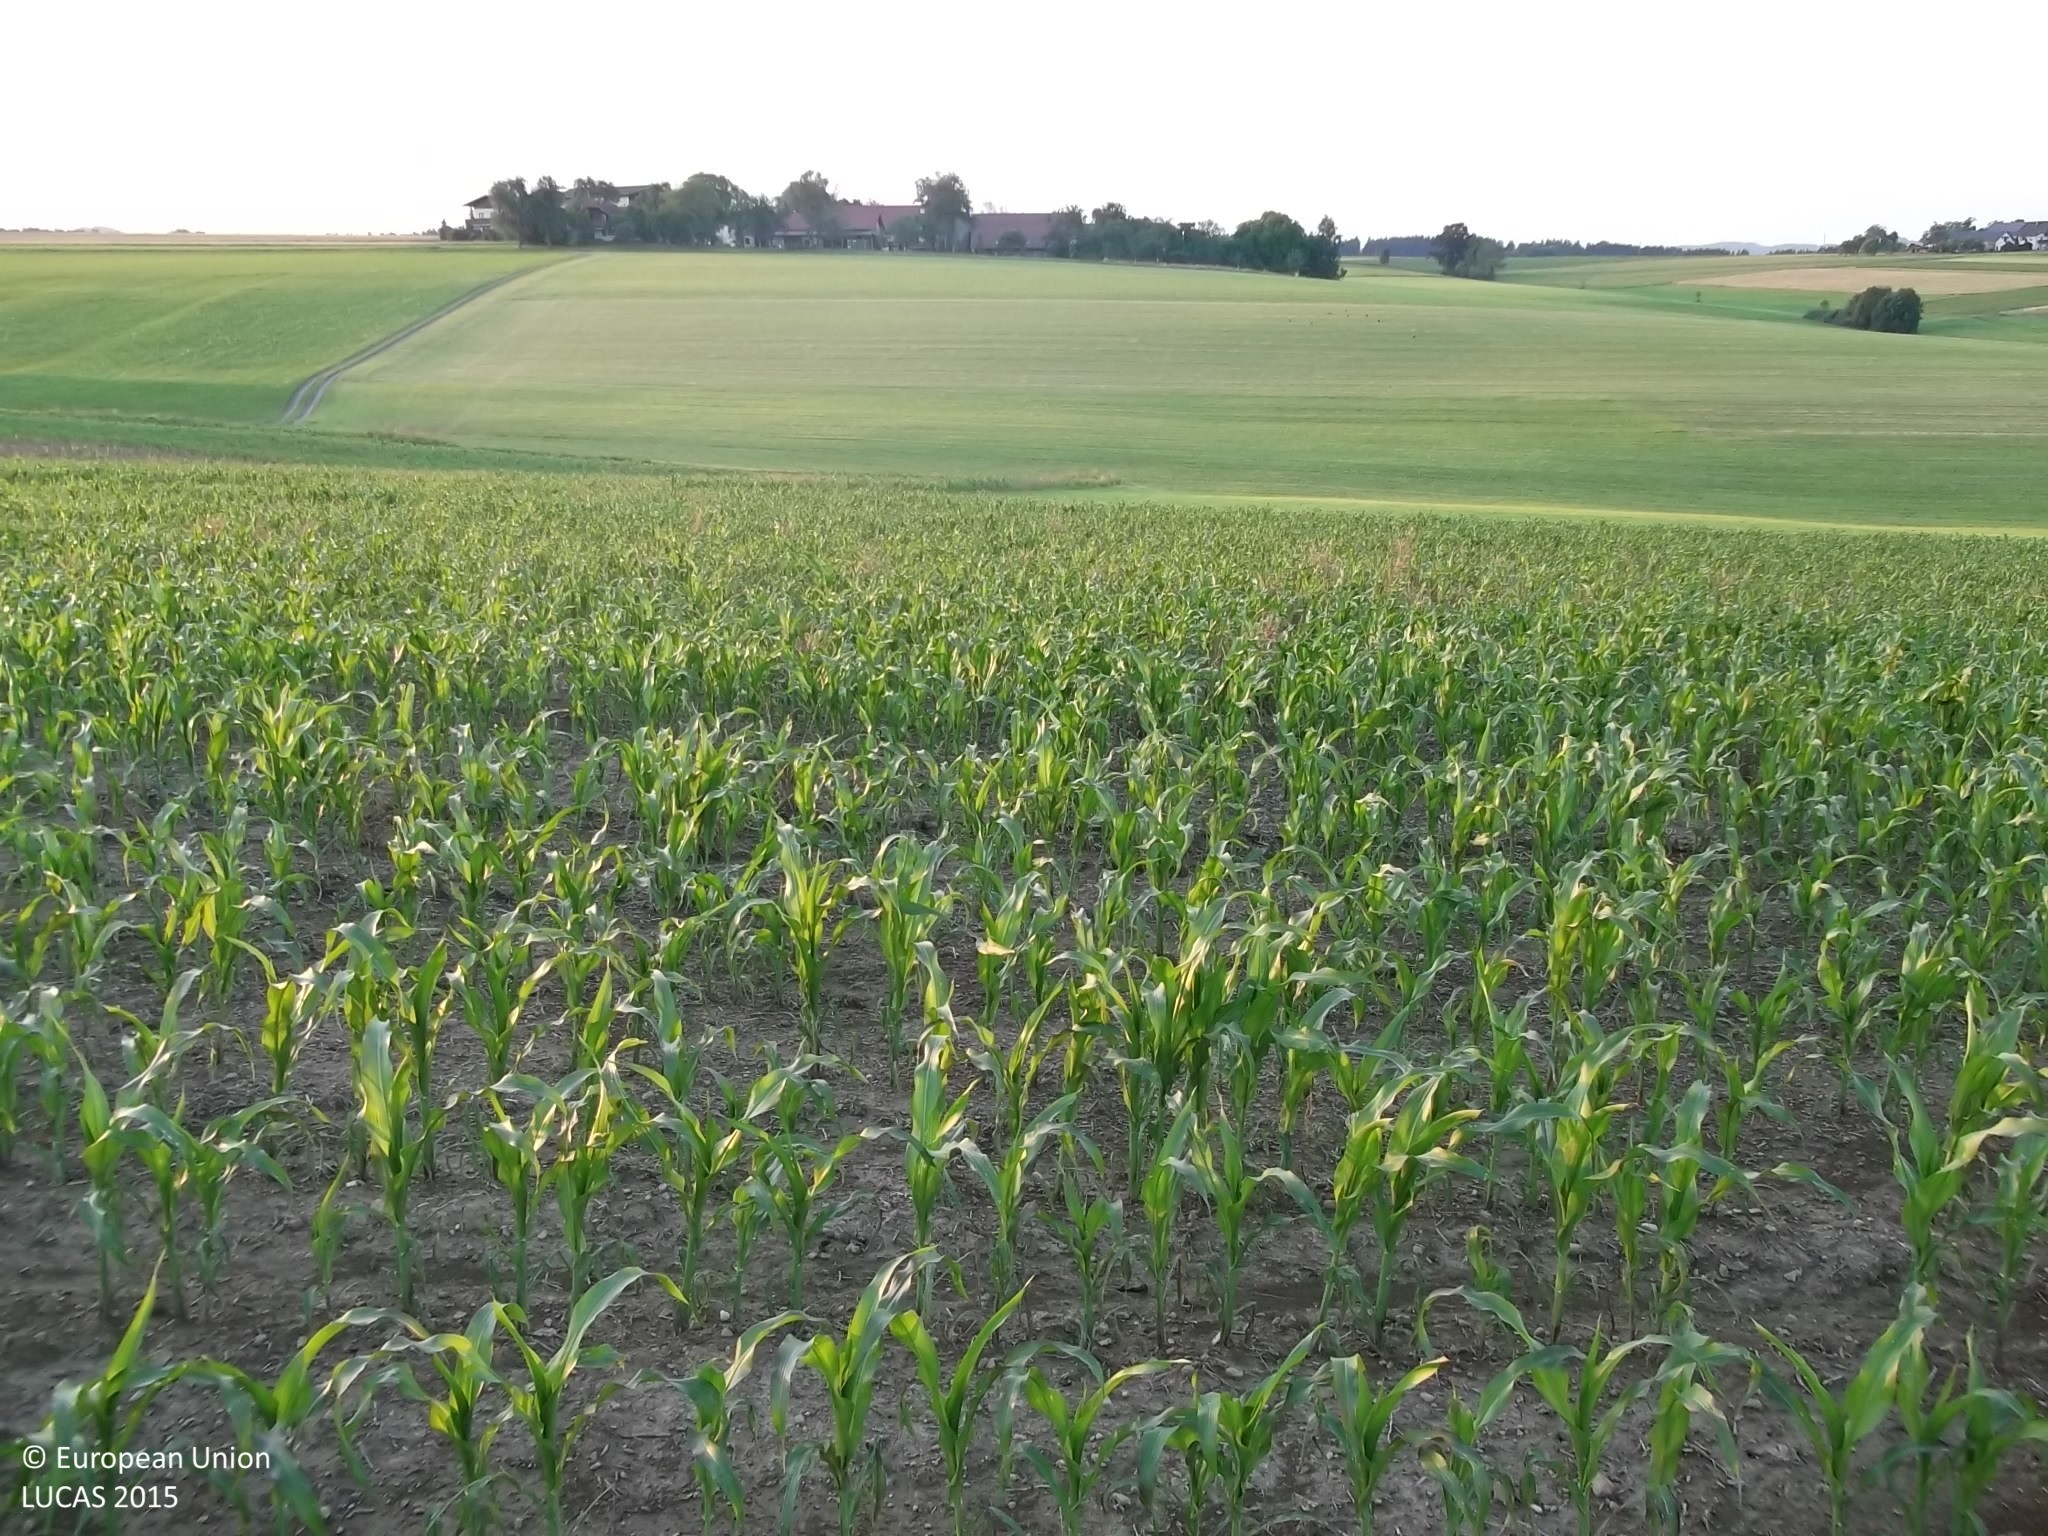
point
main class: Cropland
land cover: Maize
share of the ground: 50 - 75 %
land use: Agriculture (excluding fallow land and kitchen gardens)
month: June
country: AT
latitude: 48.0068
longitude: 13.4708
